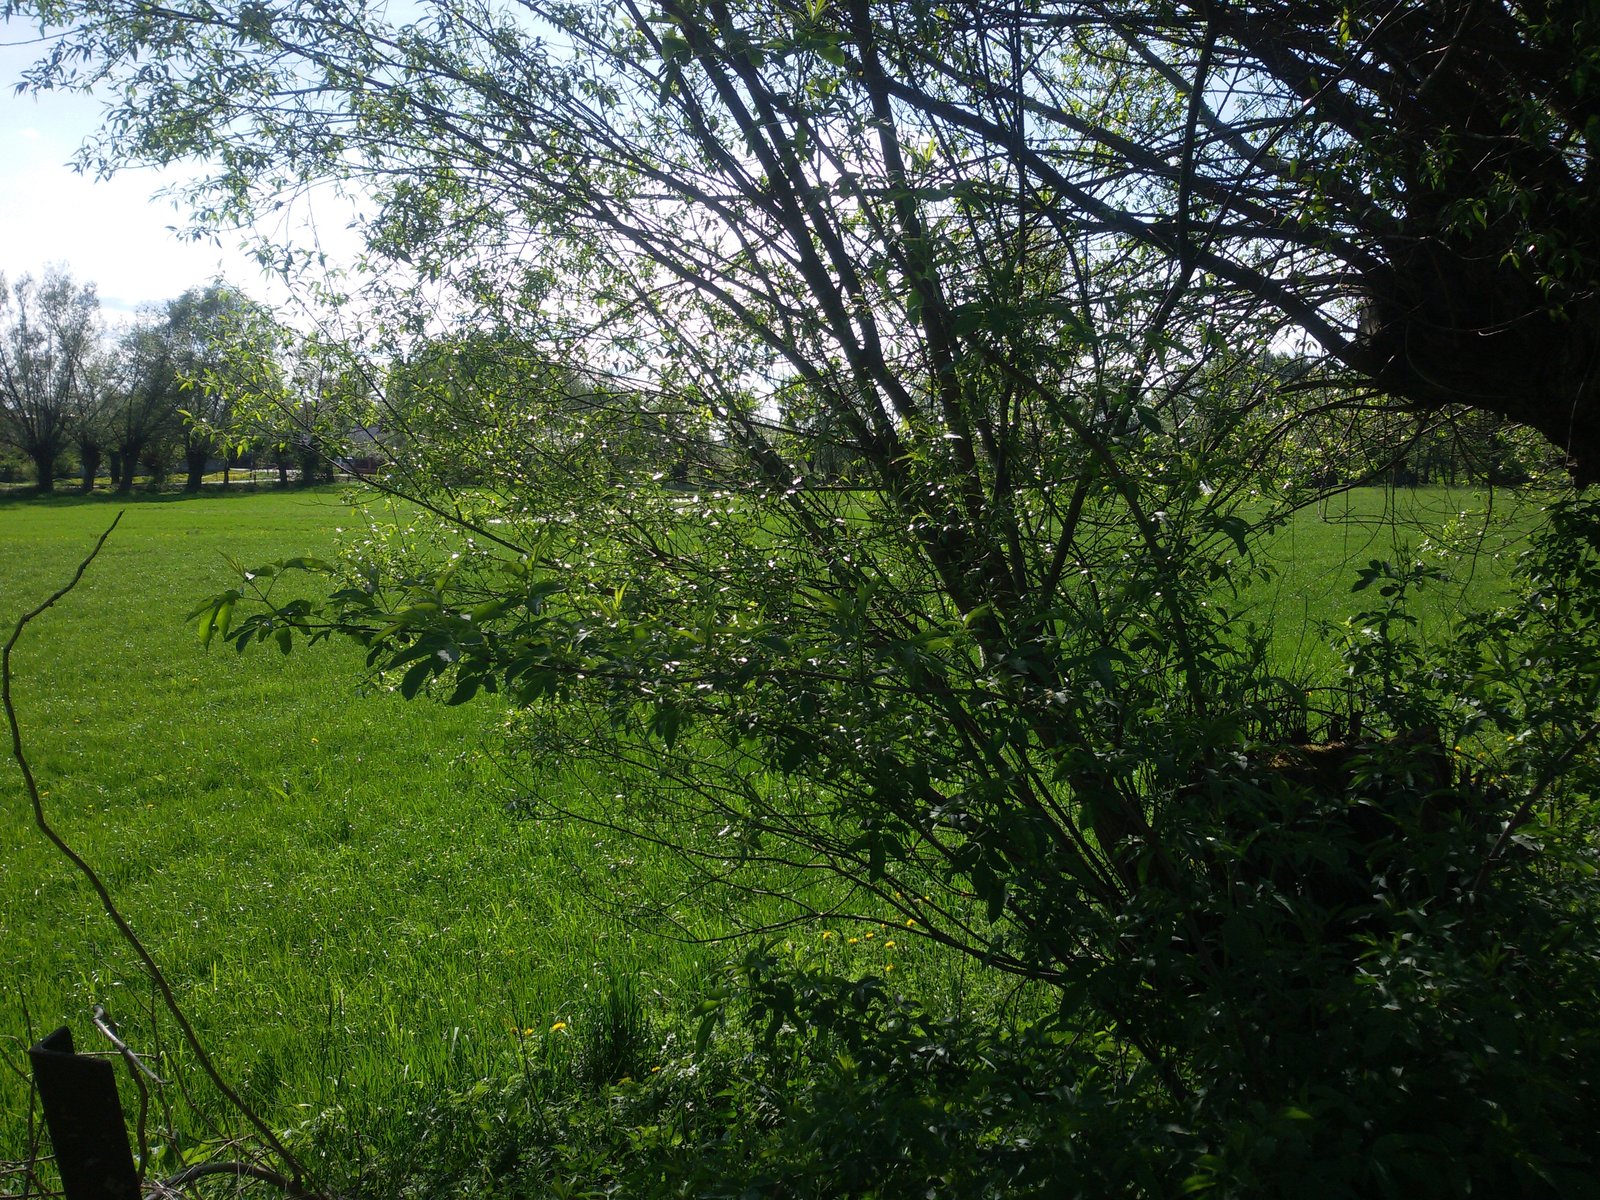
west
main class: Grassland
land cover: Grassland without tree/shrub cover
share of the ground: > 75 %
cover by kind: herbaceous plants 100 %
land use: Agriculture (excluding fallow land and kitchen gardens)
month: May
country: PL
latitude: 52.8051
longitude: 22.3309
